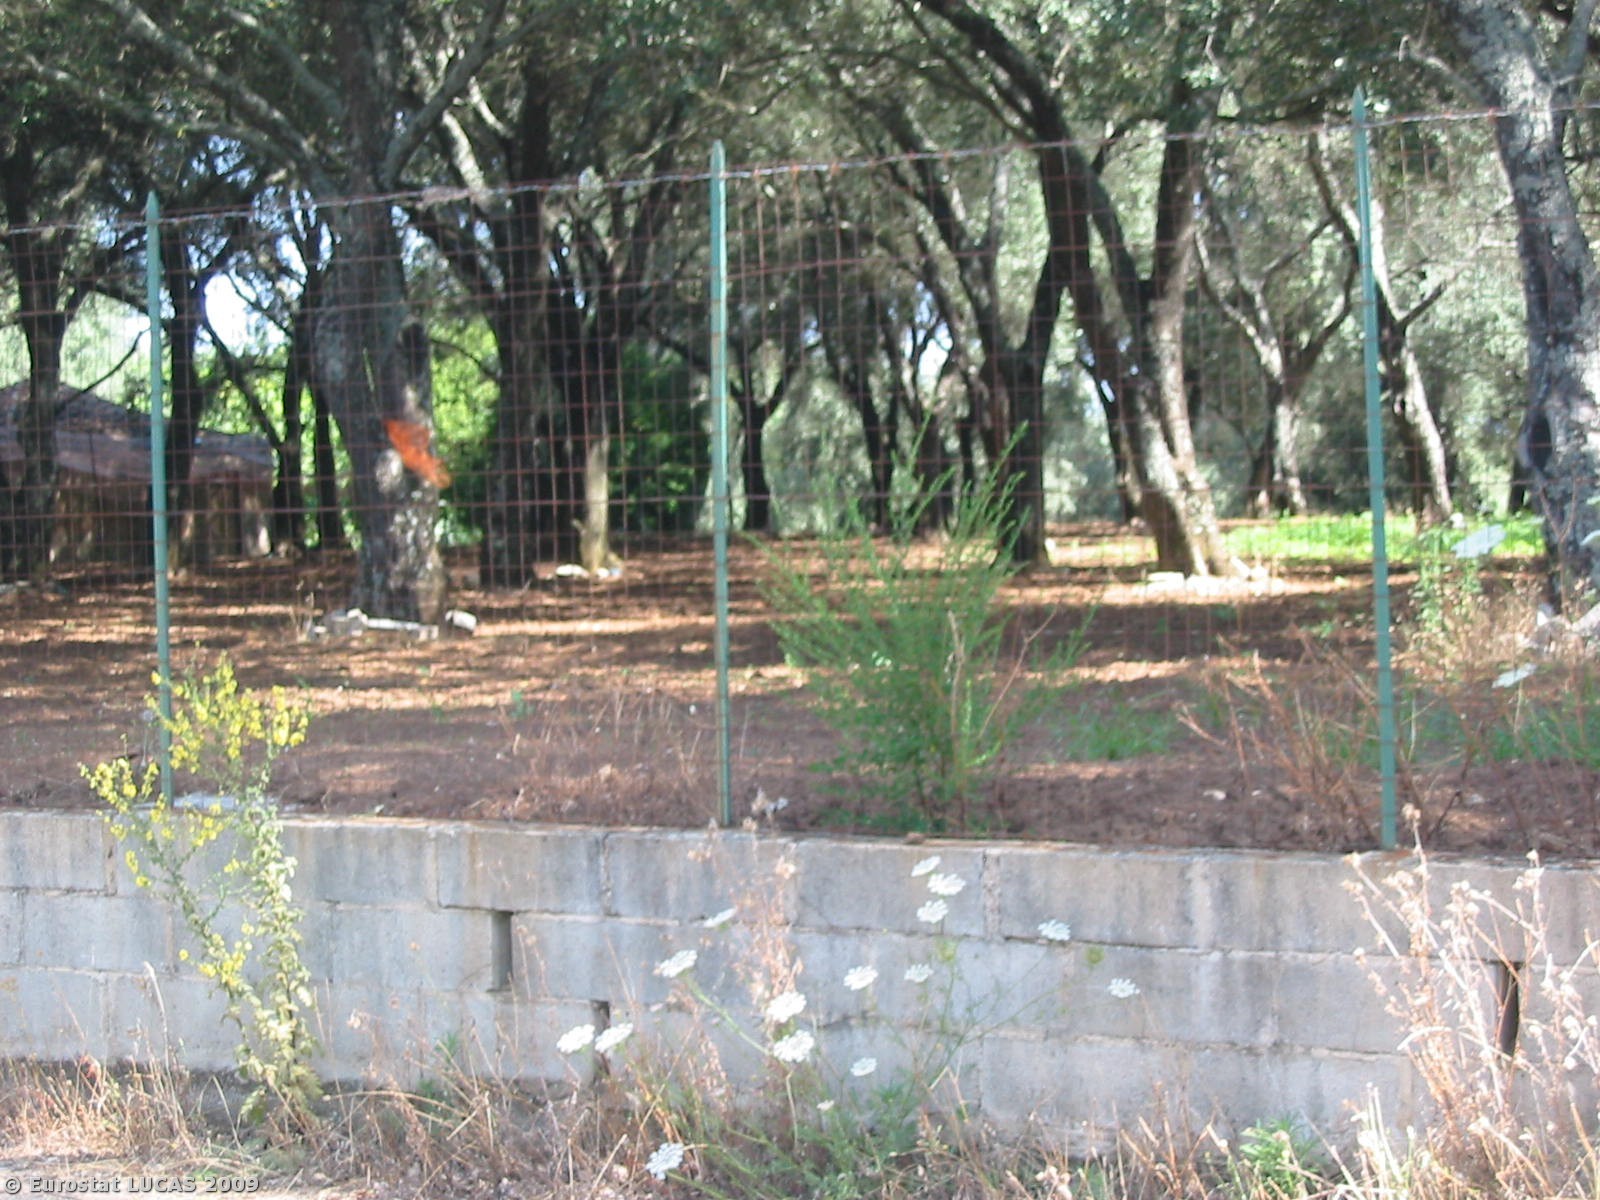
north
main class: Cropland
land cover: Olive groves
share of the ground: 50 - 75 %
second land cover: Spontaneously vegetated surfaces
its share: > 75 %
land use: Agriculture (excluding fallow land and kitchen gardens)
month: July
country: IT
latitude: 38.4446
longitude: 16.0715
